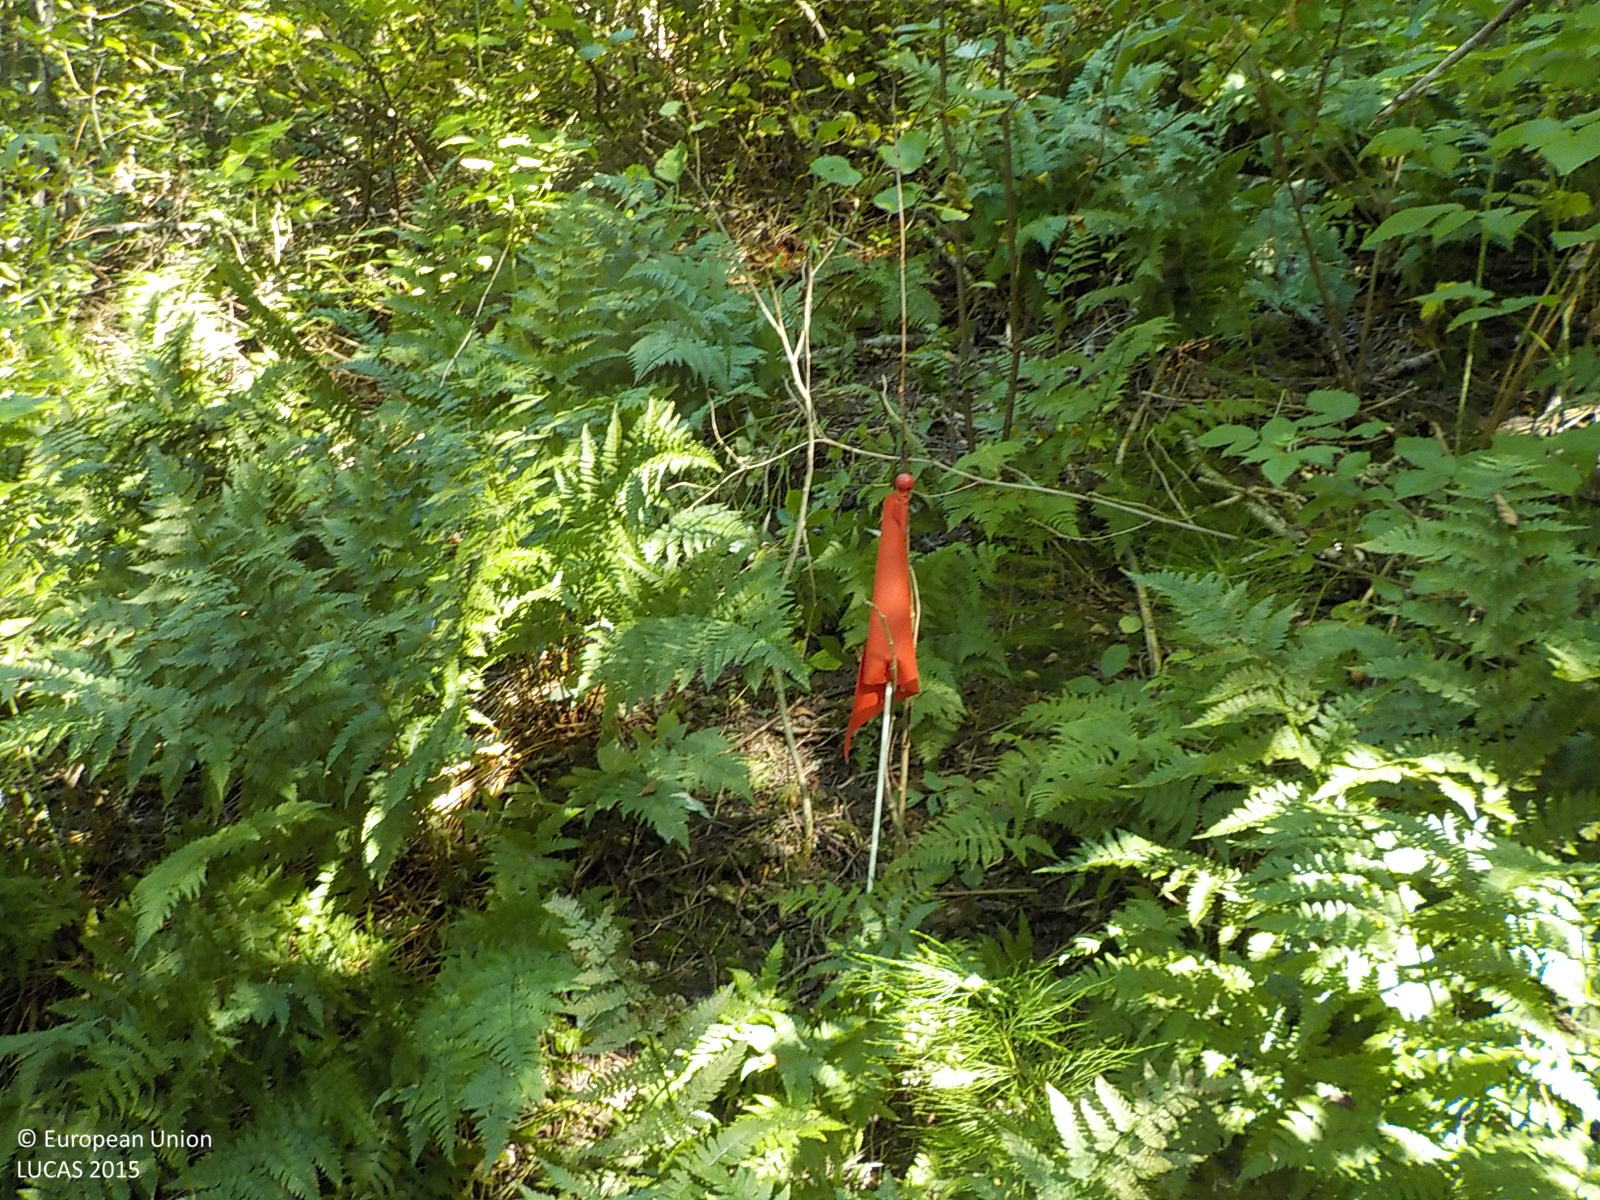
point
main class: Woodland
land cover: Broadleaved woodland
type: hemiboreal forest and nemoral coniferous forest and mixed broadleaved-coniferous forest
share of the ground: > 75 %
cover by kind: broadleaved forest trees 95 %, herbaceous plants 5 %
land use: Forestry
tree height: > 5 m
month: August
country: SE
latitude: 63.3251
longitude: 18.6630
